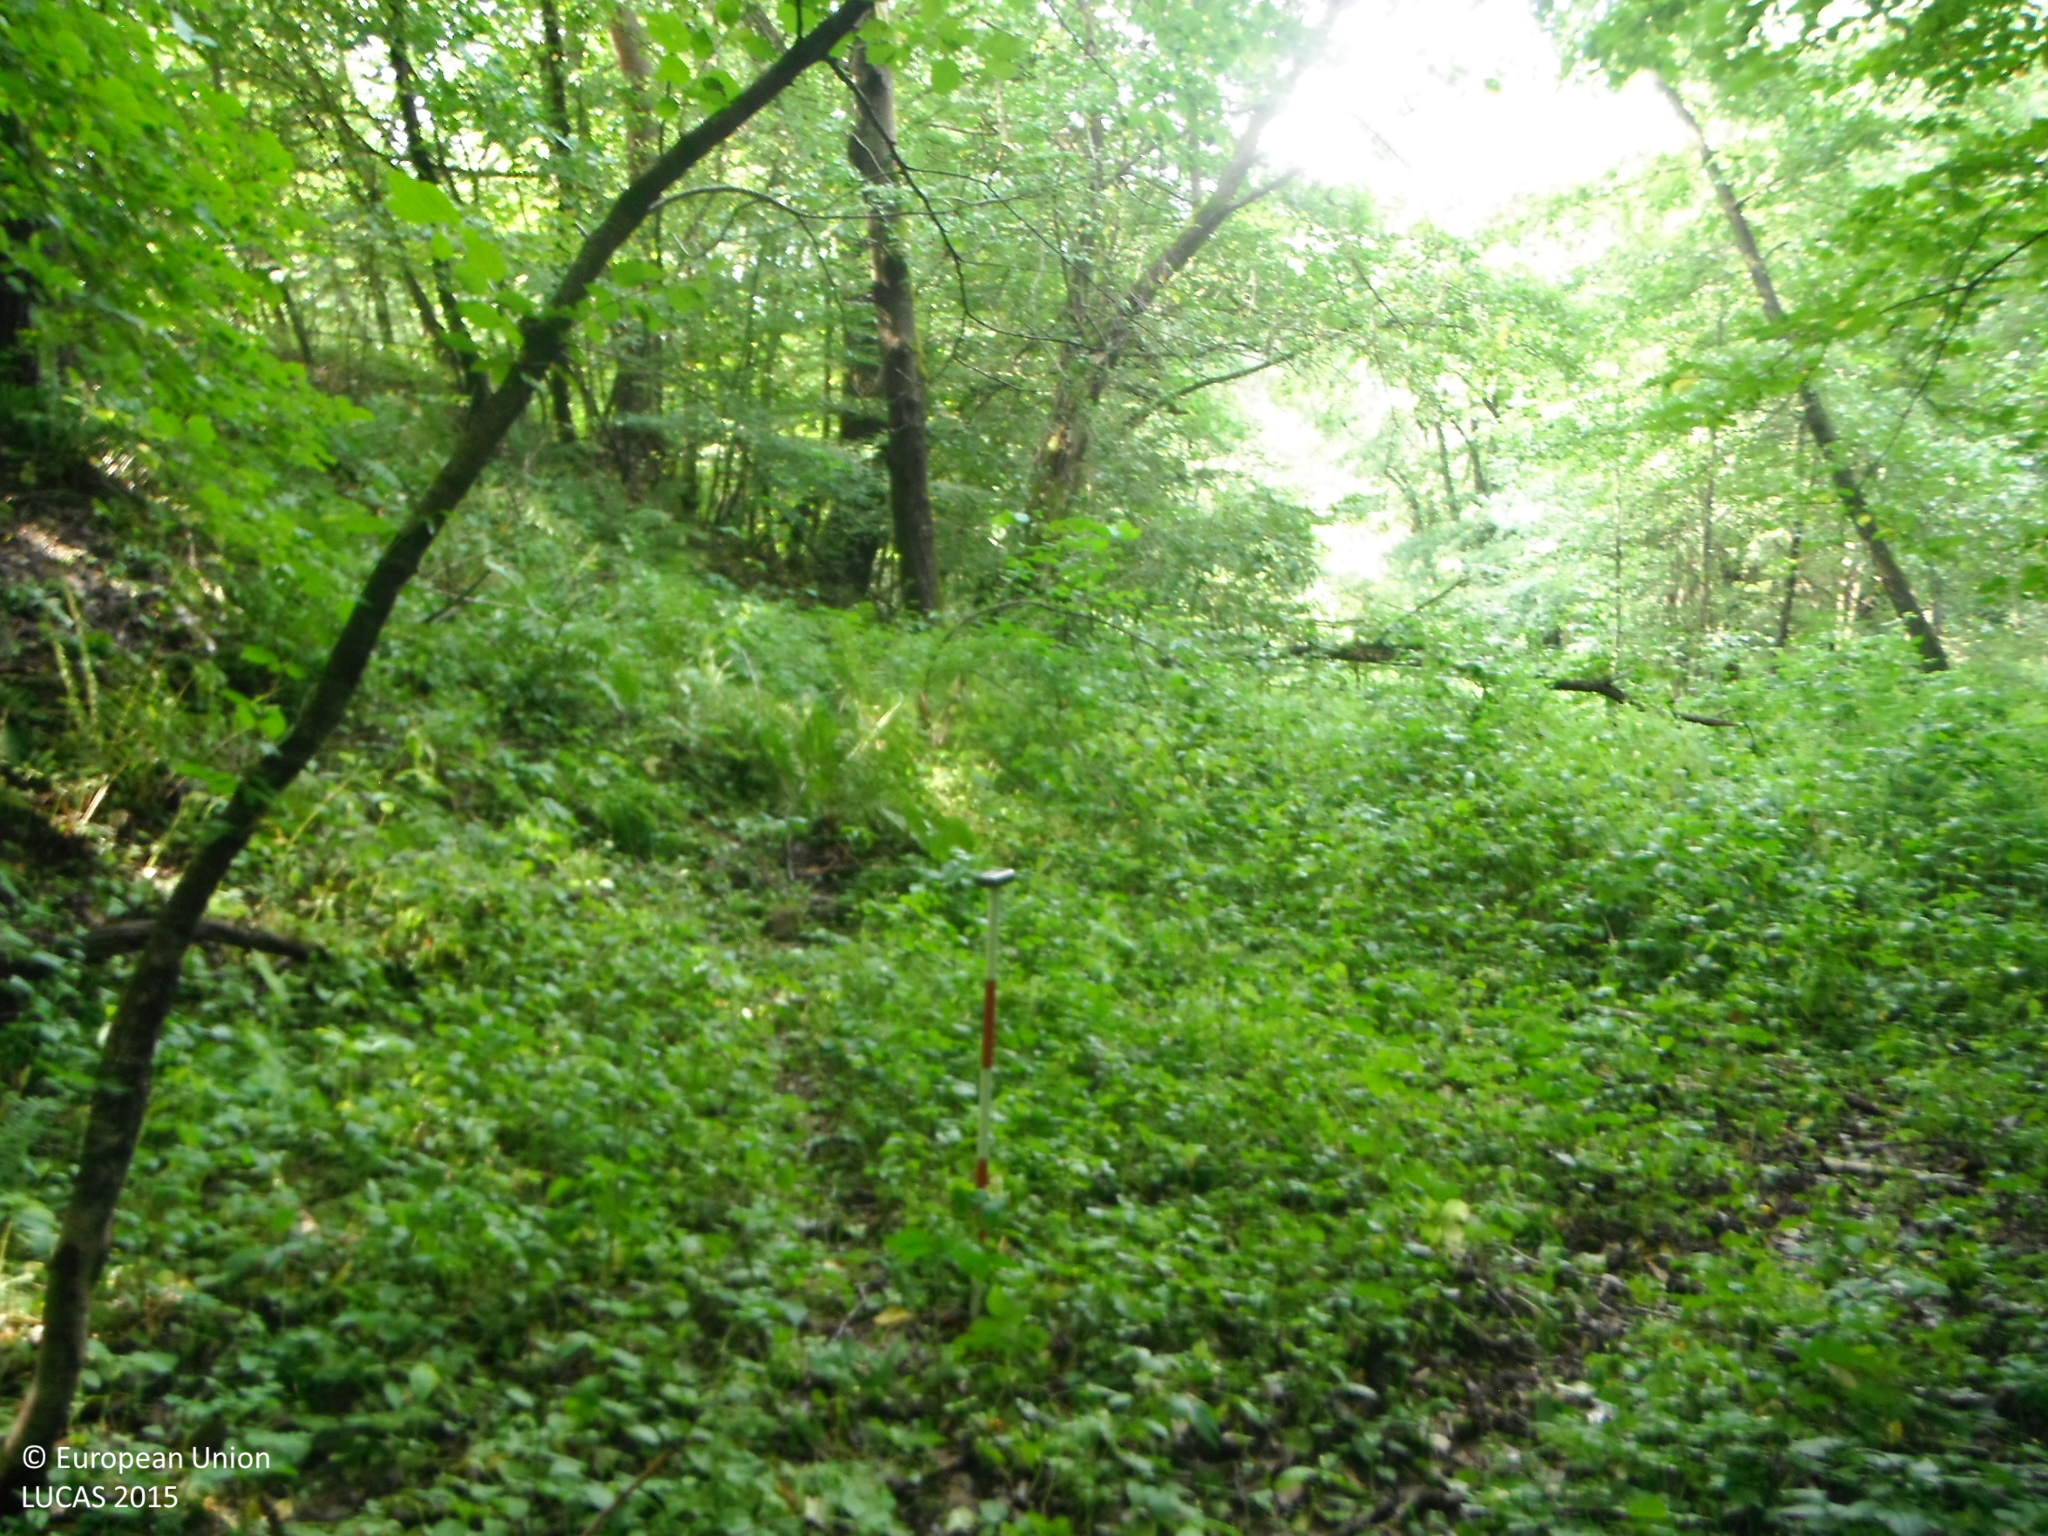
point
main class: Woodland
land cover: Broadleaved woodland
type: mesophytic deciduous forest
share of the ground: > 75 %
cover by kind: broadleaved forest trees 100 %
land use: Forestry
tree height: > 5 m
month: August
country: SK
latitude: 48.7918
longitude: 18.3607
